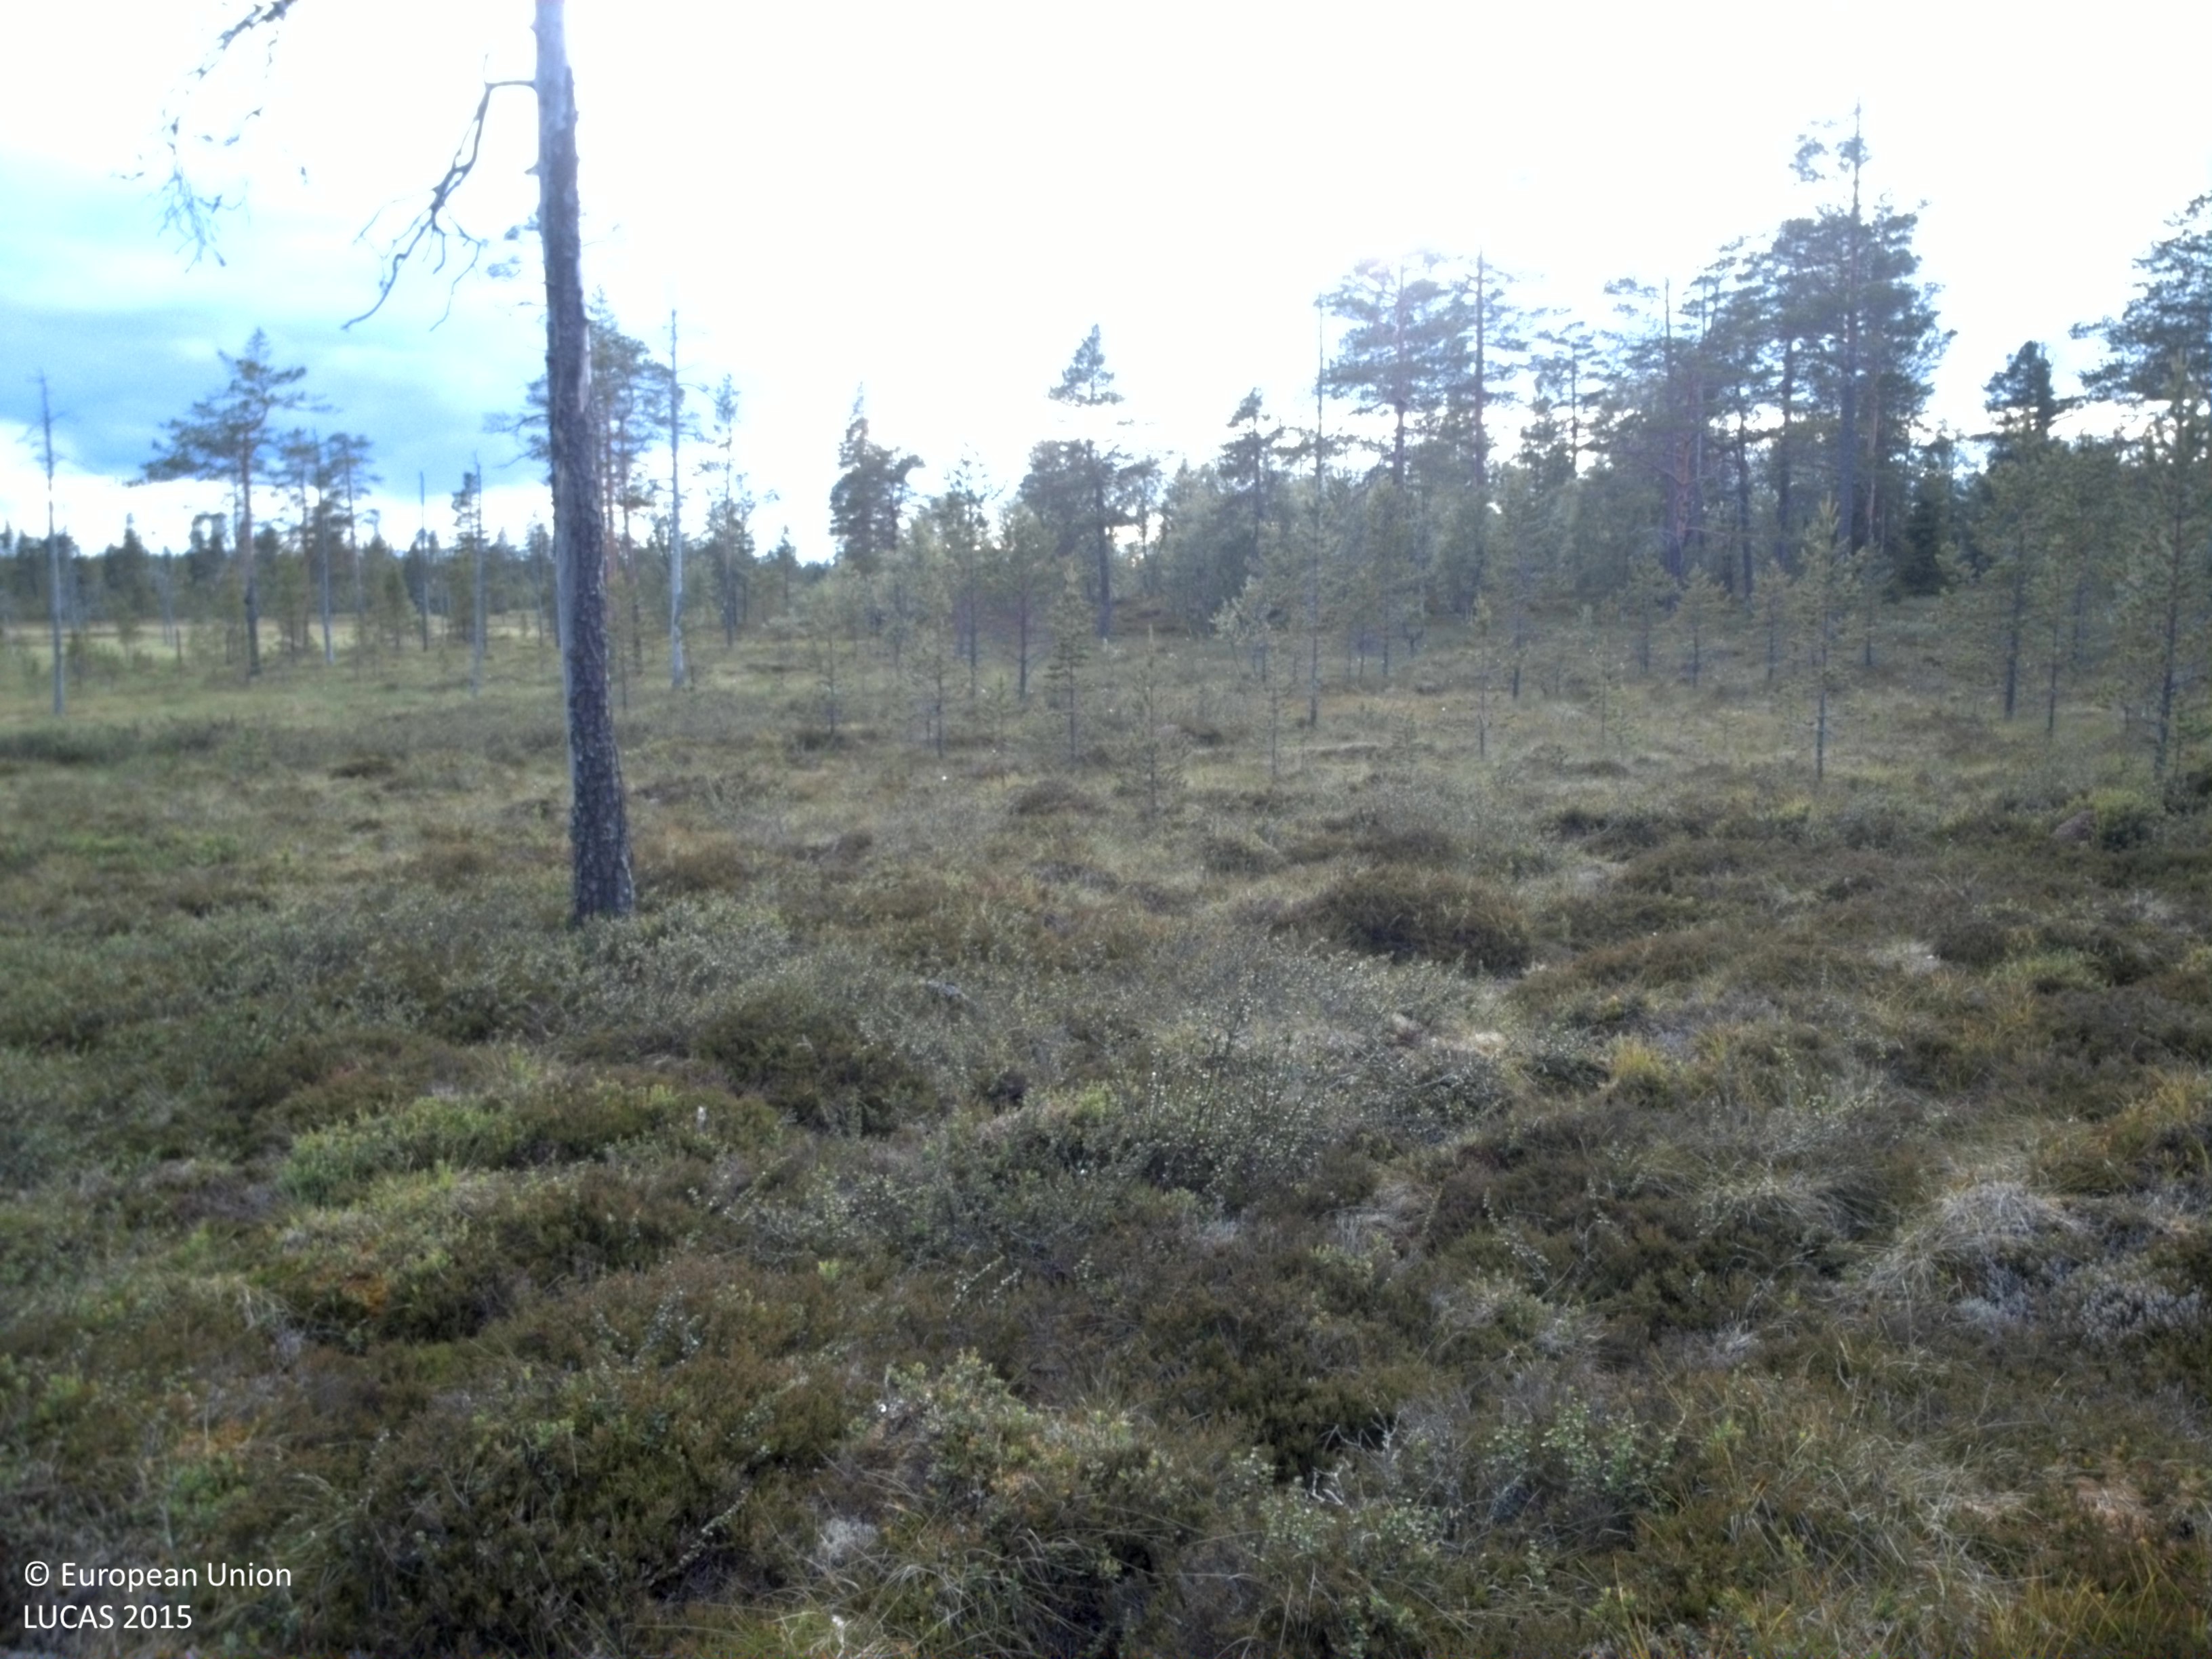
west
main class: Woodland
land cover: Pine dominated coniferous woodland
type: boreal forest
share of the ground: 10 - 25 %
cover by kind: shrubs 40 %, lichens and mosses 35 %, coniferous forest trees 15 %, herbaceous plants 10 %
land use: Forestry
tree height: < 5 m
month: July
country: SE
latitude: 61.5944
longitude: 13.6236
